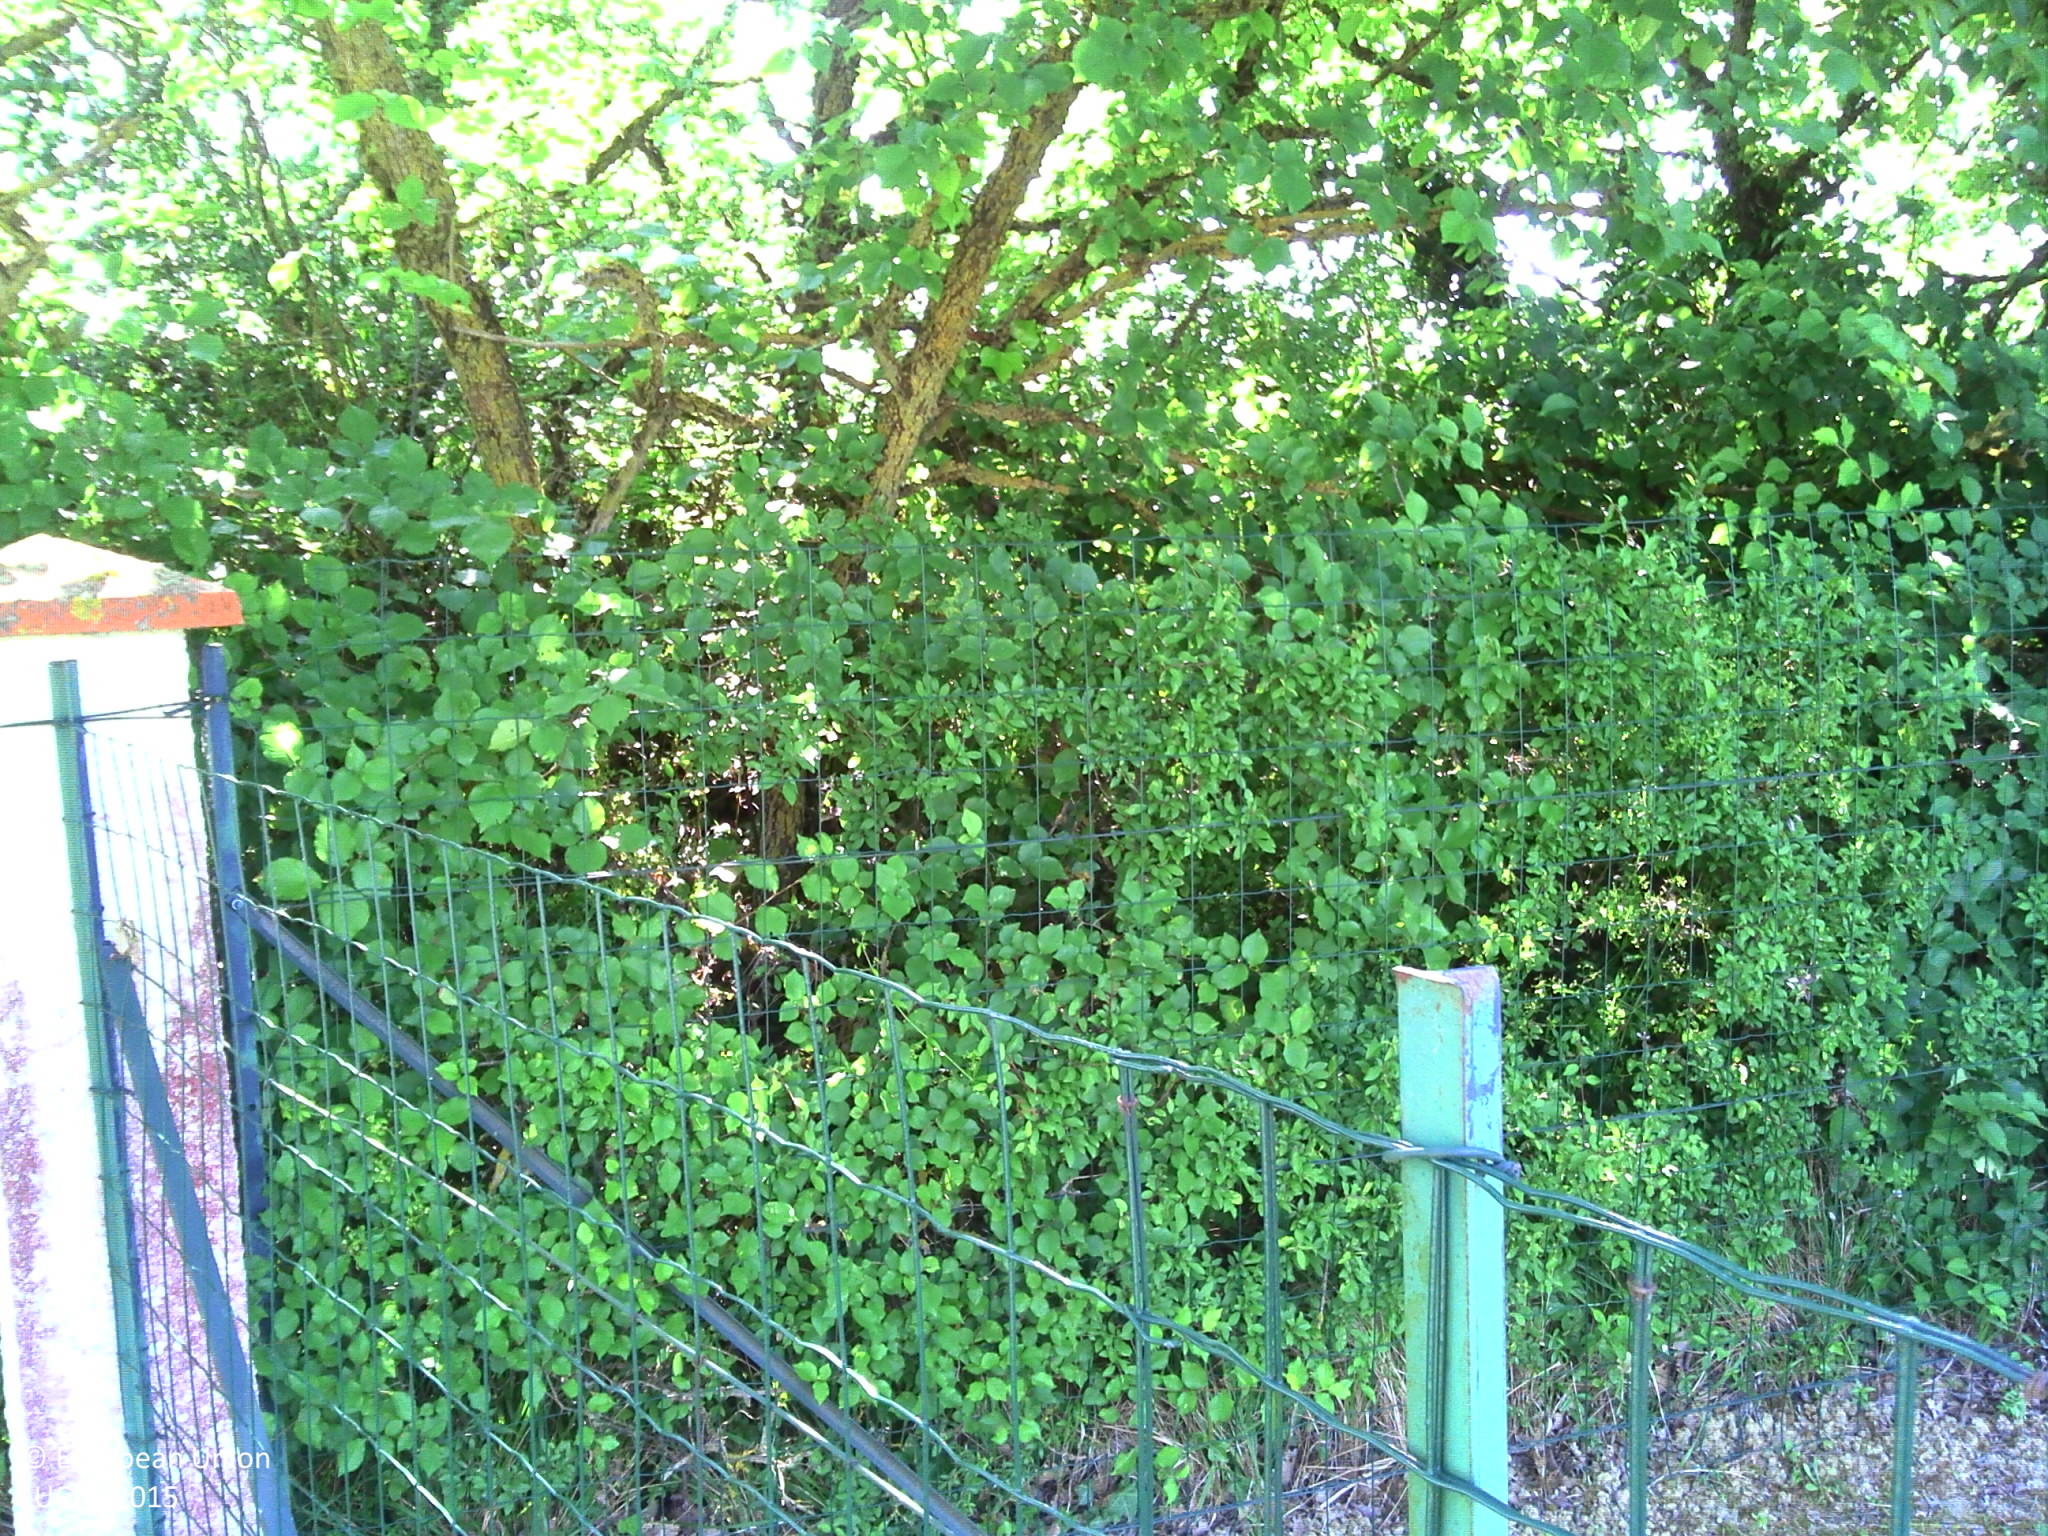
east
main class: Grassland
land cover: Grassland with sparse tree/shrub cover
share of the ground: > 75 %
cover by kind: herbaceous plants 95 %, broadleaved forest trees 5 %
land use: Residential
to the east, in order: Grassland with sparse tree/shrub cover; Fences; Broadleaved woodland; Tracks; Durum wheat; Electric lines; Durum wheat
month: June
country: FR
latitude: 43.6586
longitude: 0.6858
